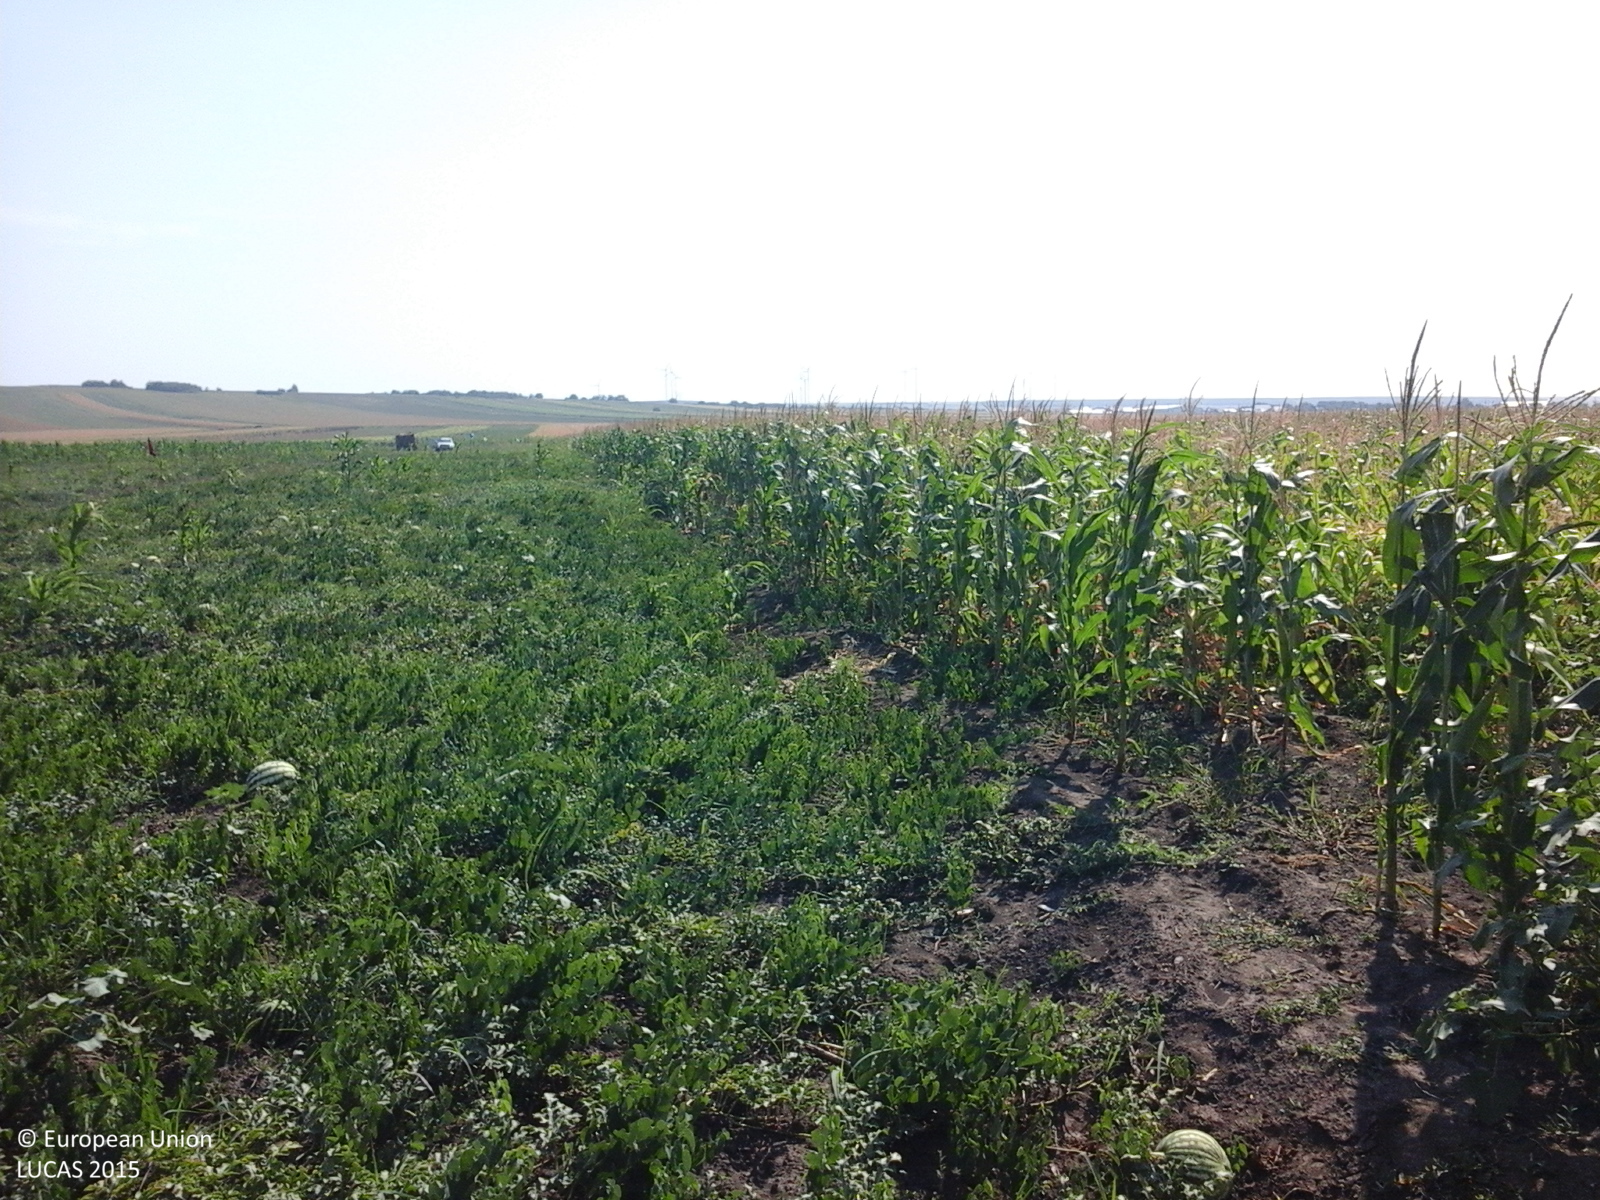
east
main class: Cropland
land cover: Maize
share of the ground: > 75 %
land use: Agriculture (excluding fallow land and kitchen gardens)
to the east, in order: Maize
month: August
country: RO
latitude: 45.8430
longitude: 27.6603
